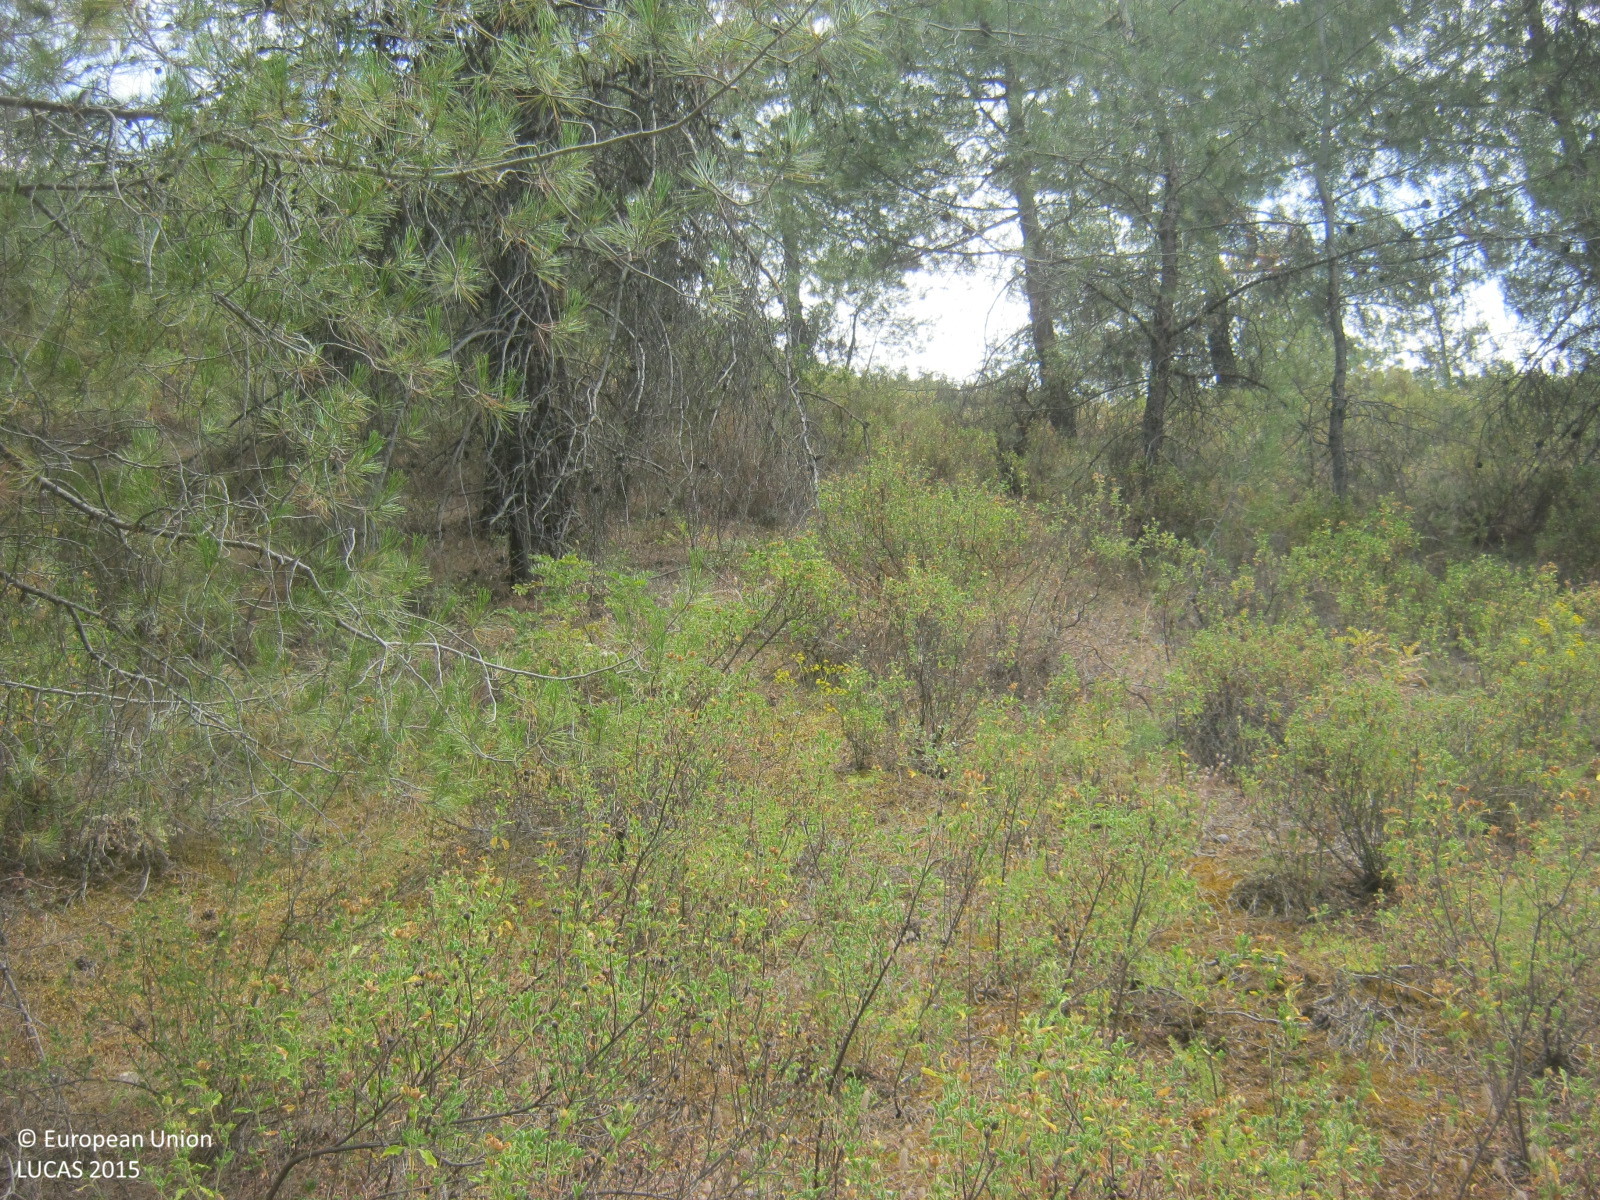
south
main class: Woodland
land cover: Pine dominated coniferous woodland
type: coniferous forest of the mediterranean region
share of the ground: 50 - 75 %
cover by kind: coniferous forest trees 60 %, shrubs 20 %, herbaceous plants 10 %, unconsolidated bare surface 10 %
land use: Forestry
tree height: > 5 m
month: June
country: CY
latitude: 34.9752
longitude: 33.1711
